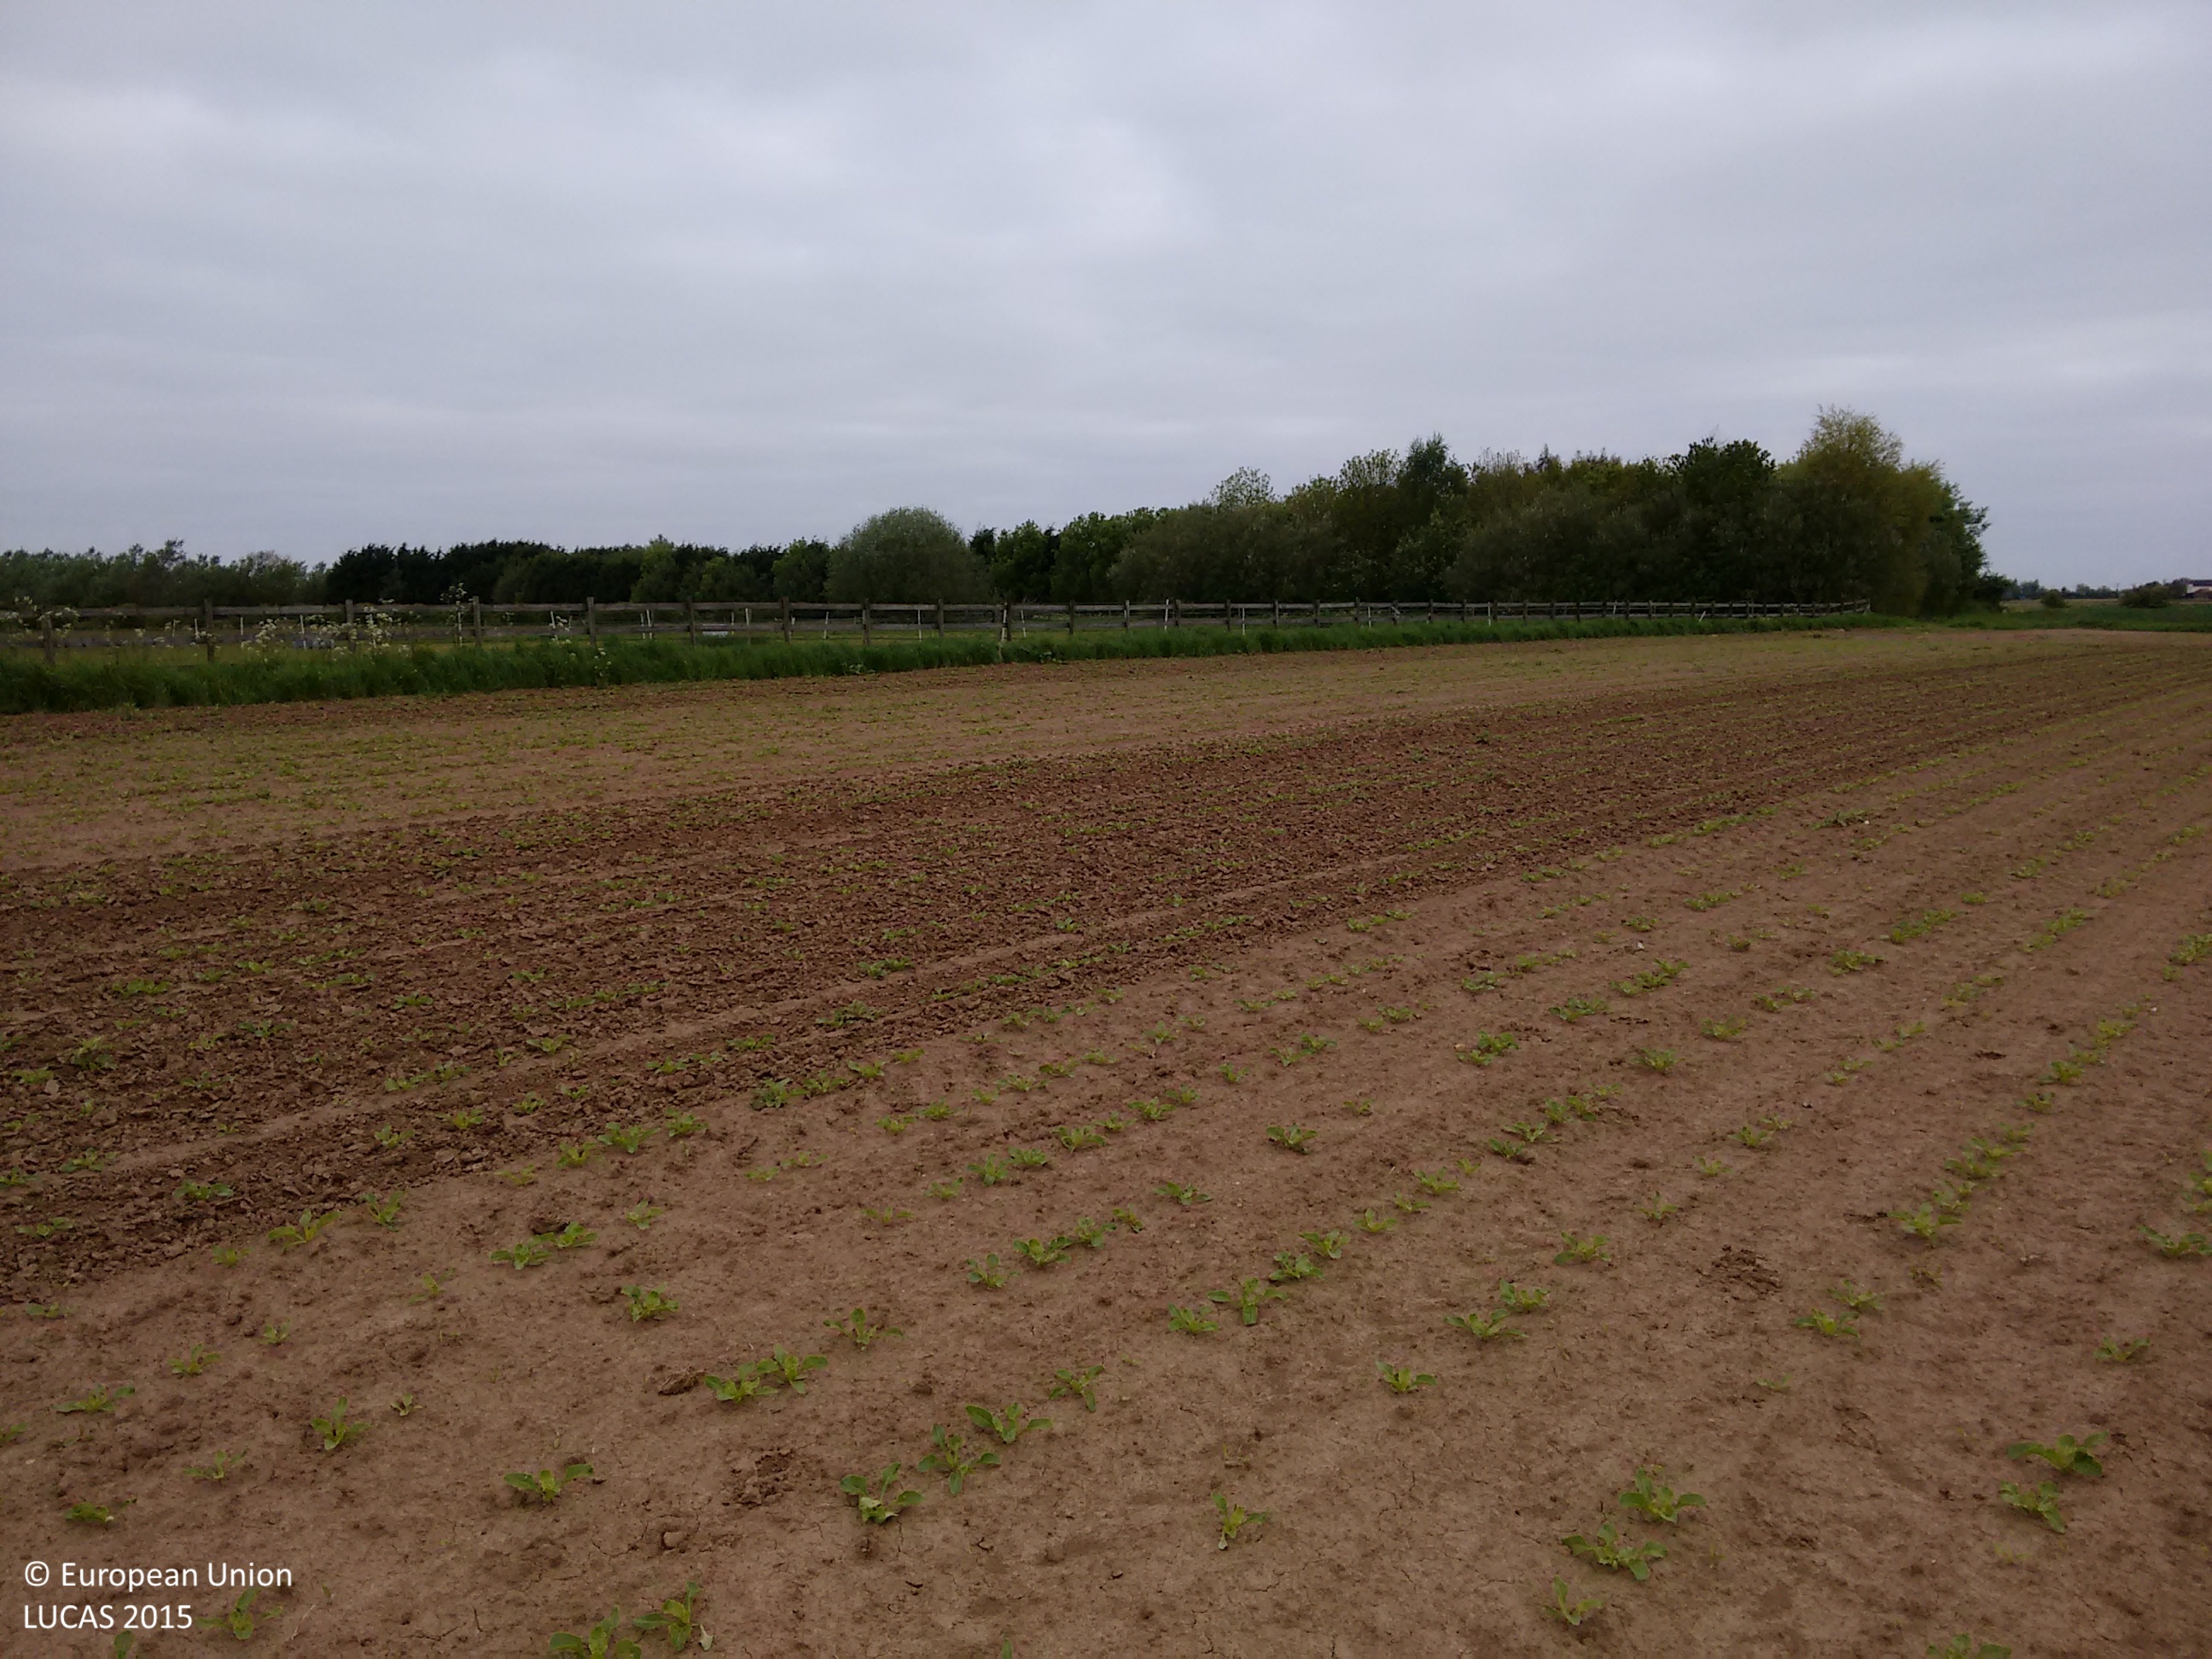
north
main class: Cropland
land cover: Other fresh vegetables
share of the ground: < 10 %
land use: Agriculture (excluding fallow land and kitchen gardens)
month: May
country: GB
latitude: 52.8731
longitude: -0.0614
